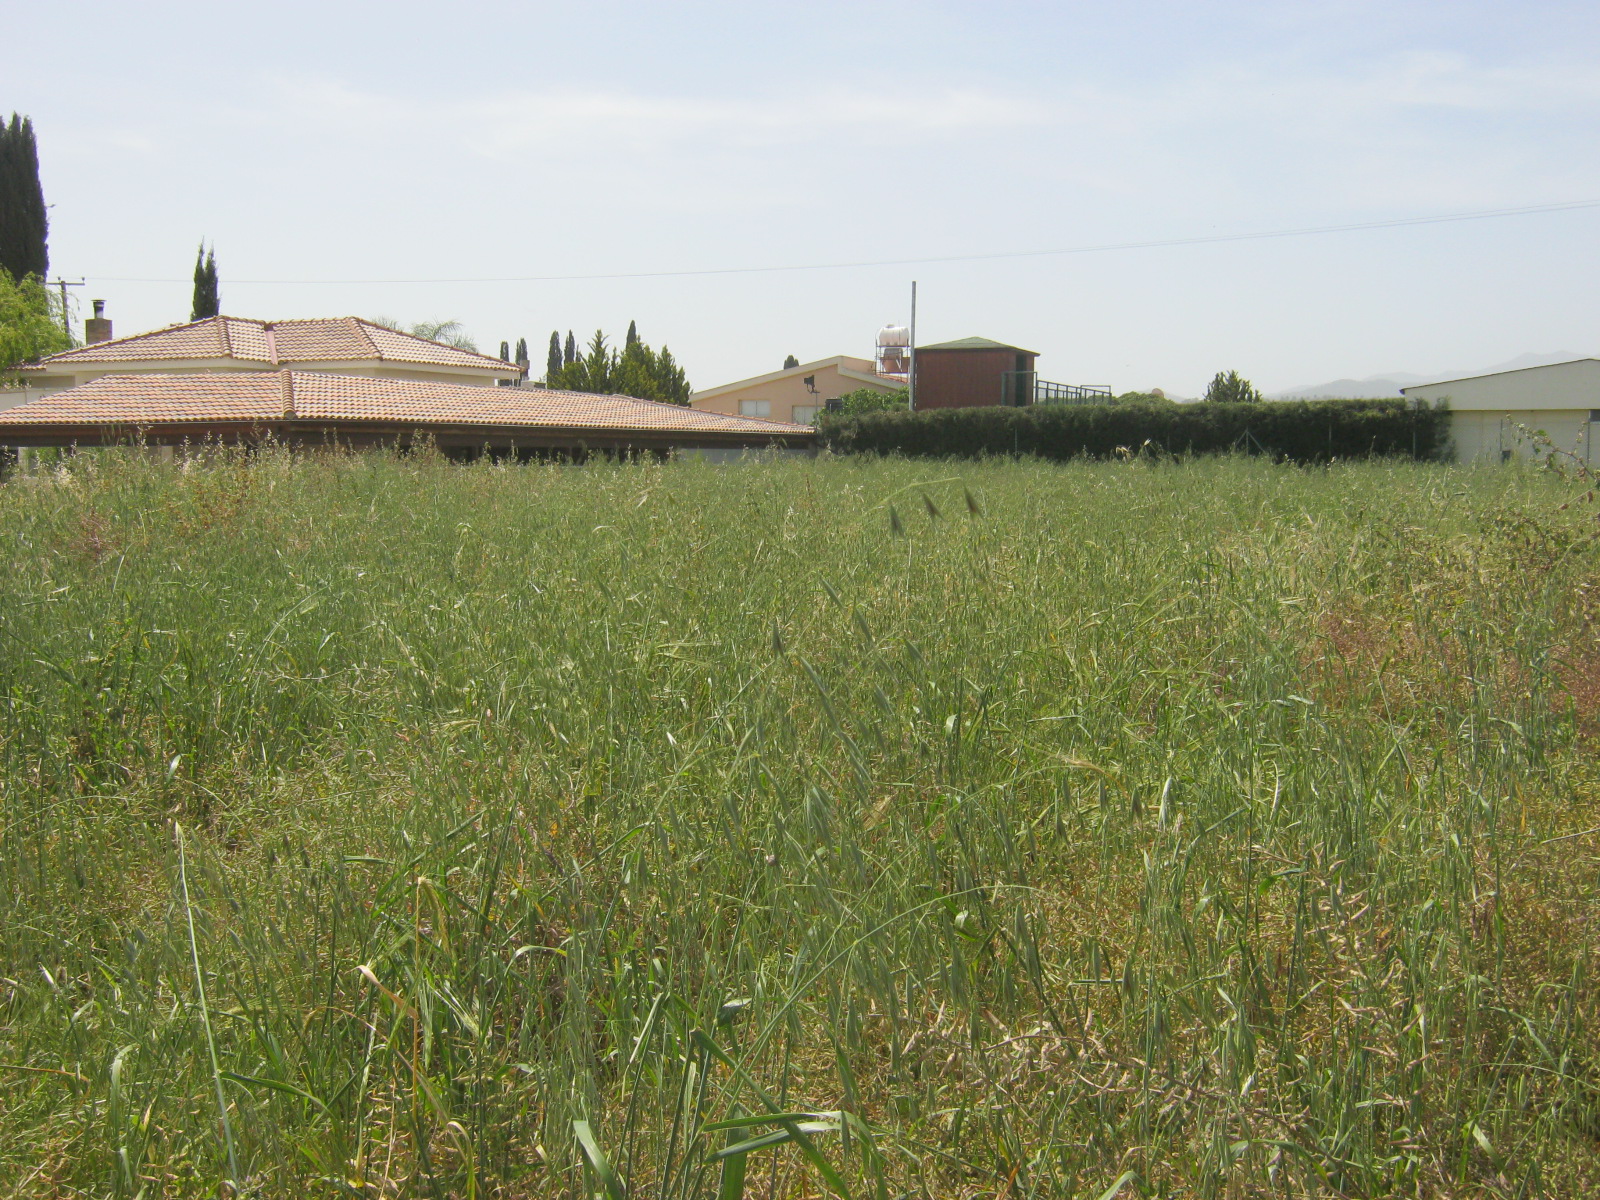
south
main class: Grassland
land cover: Spontaneously vegetated surfaces
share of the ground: > 75 %
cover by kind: herbaceous plants 100 %
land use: Residential
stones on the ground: < 10 %
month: April
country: CY
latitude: 35.0508
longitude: 33.2415
